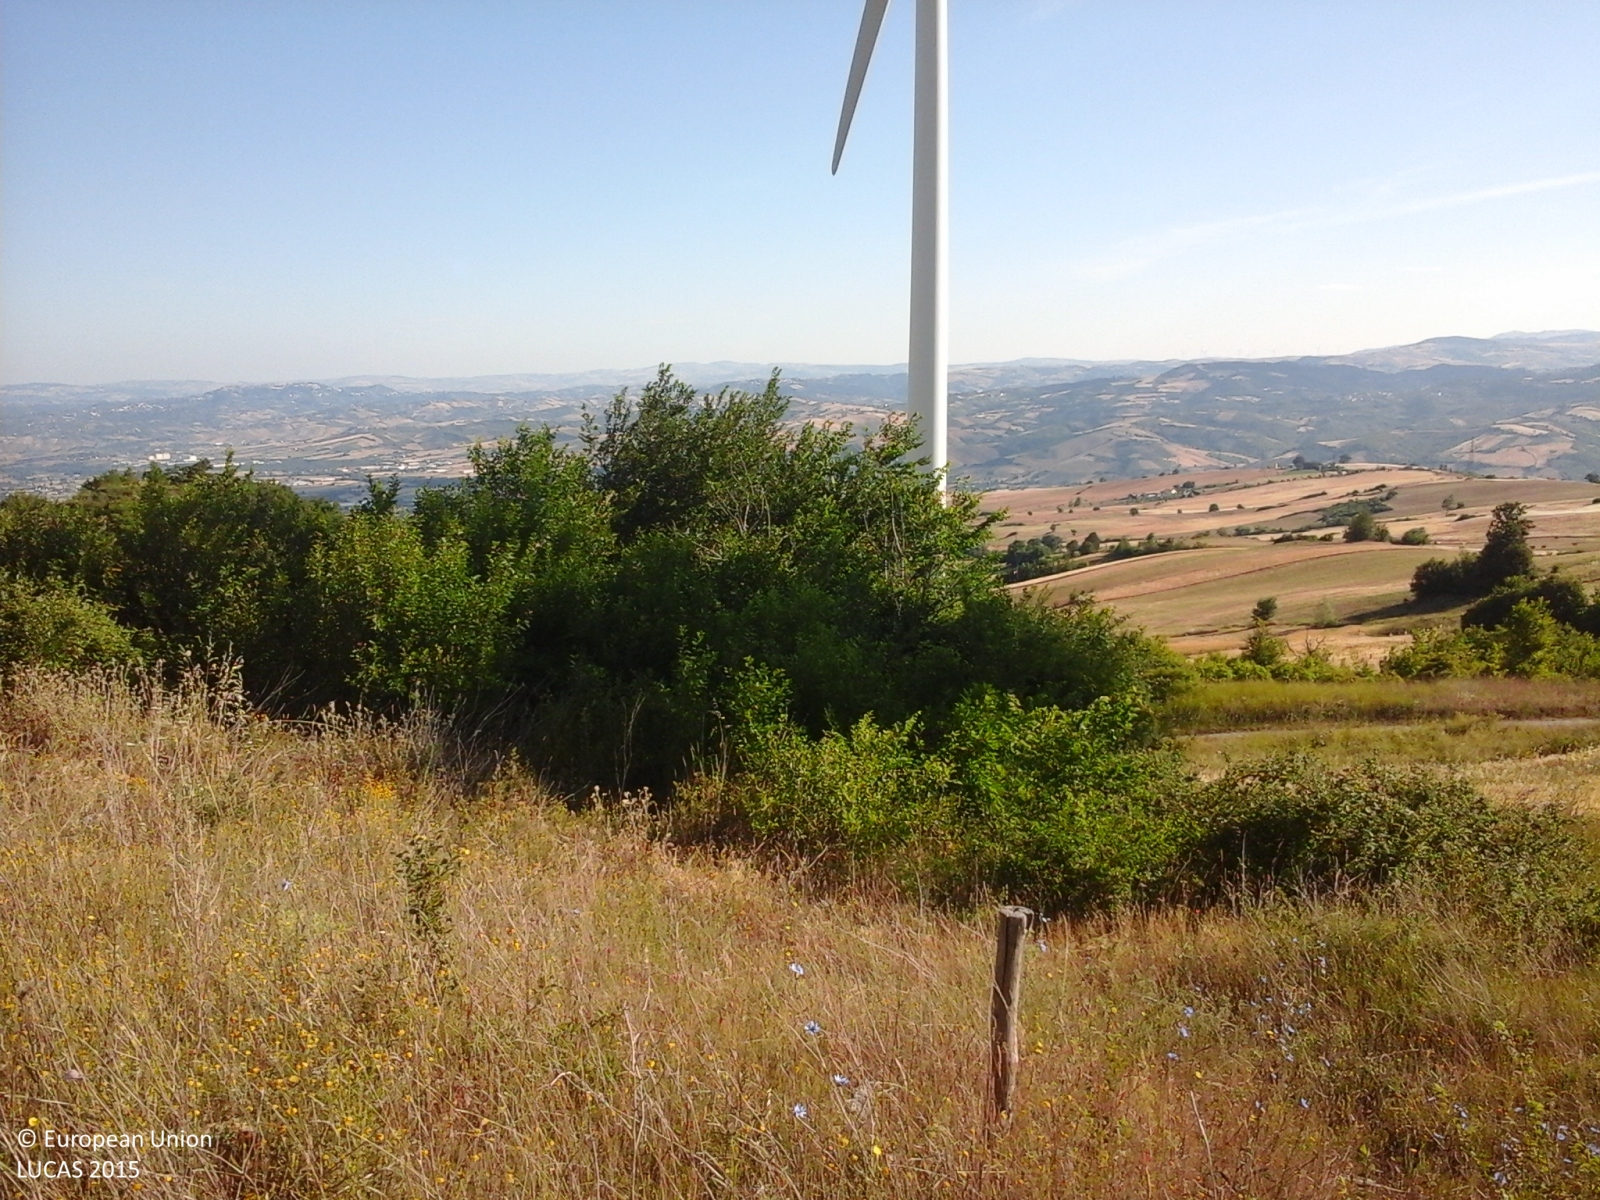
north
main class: Grassland
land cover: Grassland with sparse tree/shrub cover
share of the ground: > 75 %
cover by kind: herbaceous plants 85 %, shrubs 10 %, broadleaved forest trees 5 %
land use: Abandoned areas
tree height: < 5 m
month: June
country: IT
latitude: 40.9840
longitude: 15.1507
